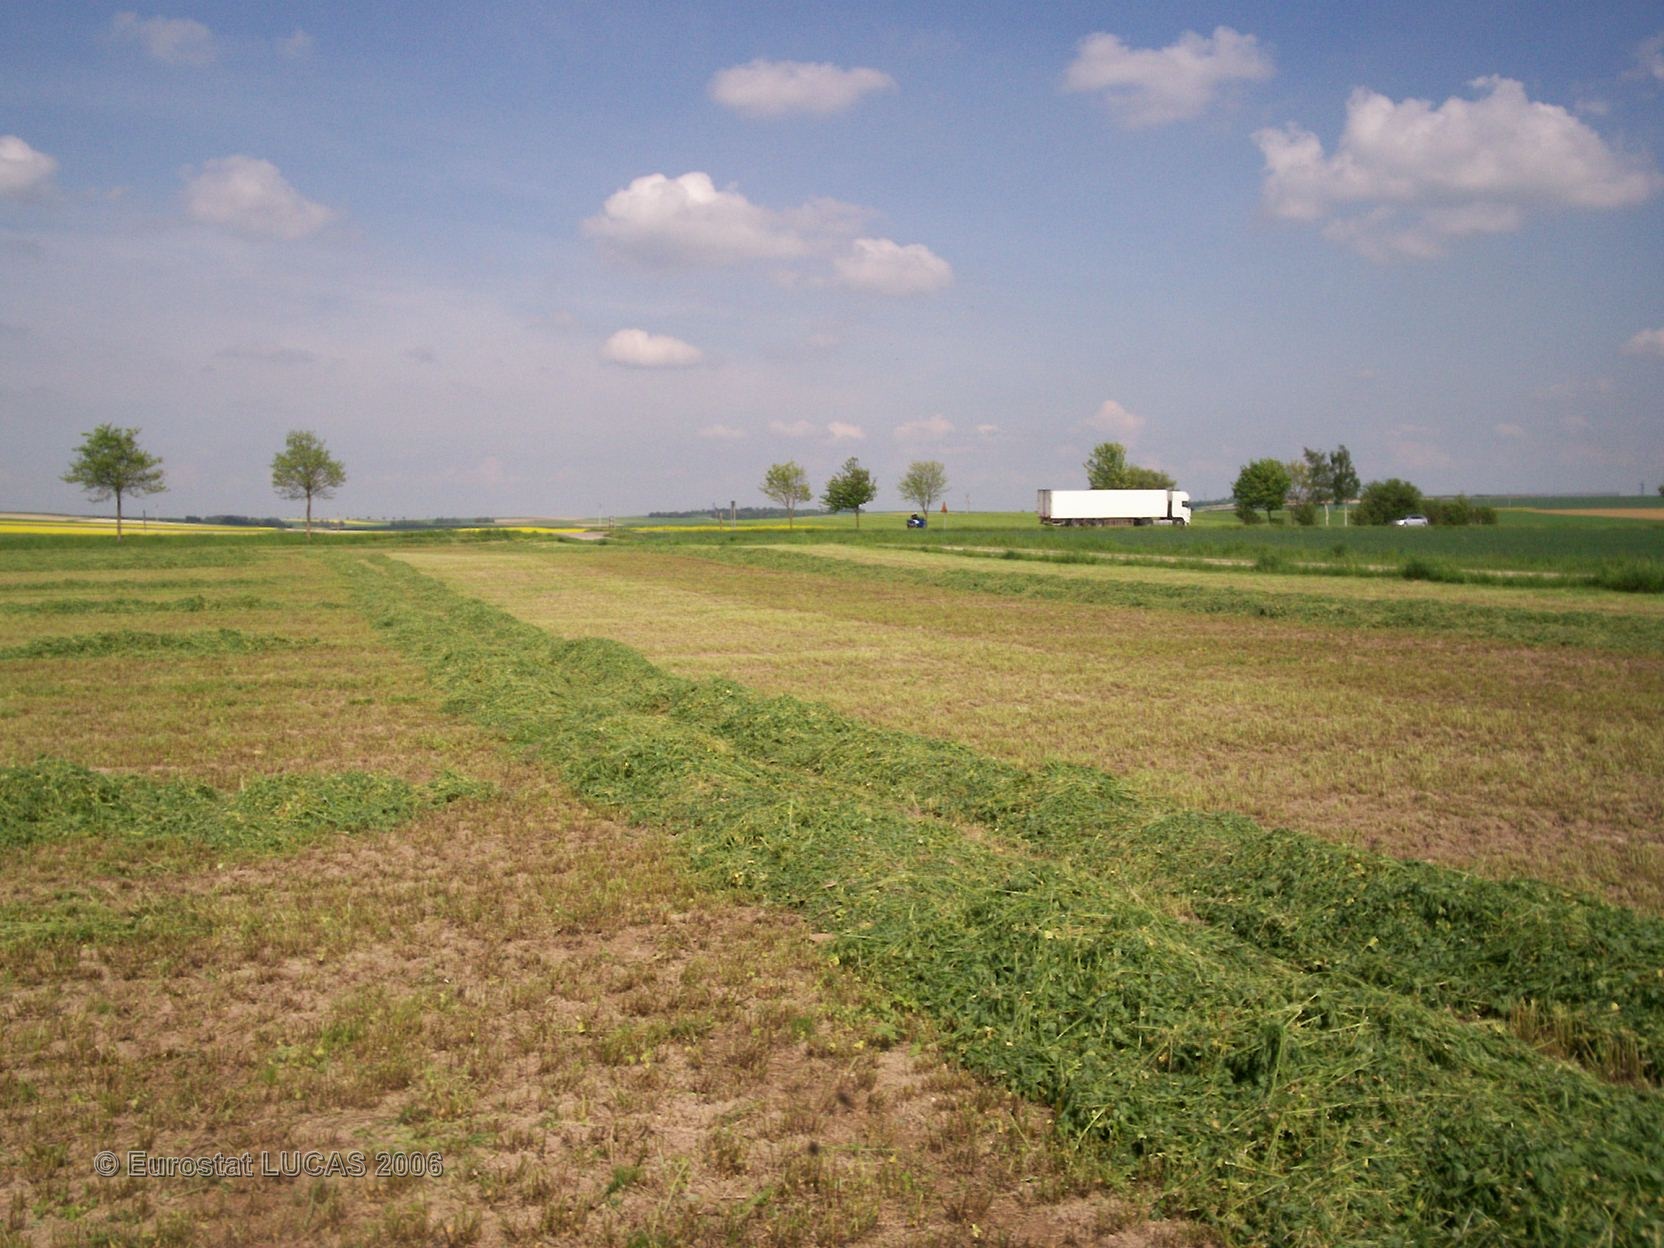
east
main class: Cropland
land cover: Lucerne
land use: Agriculture (excluding fallow land and kitchen gardens)
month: May
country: FR
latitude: 48.8951
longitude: 4.4451
